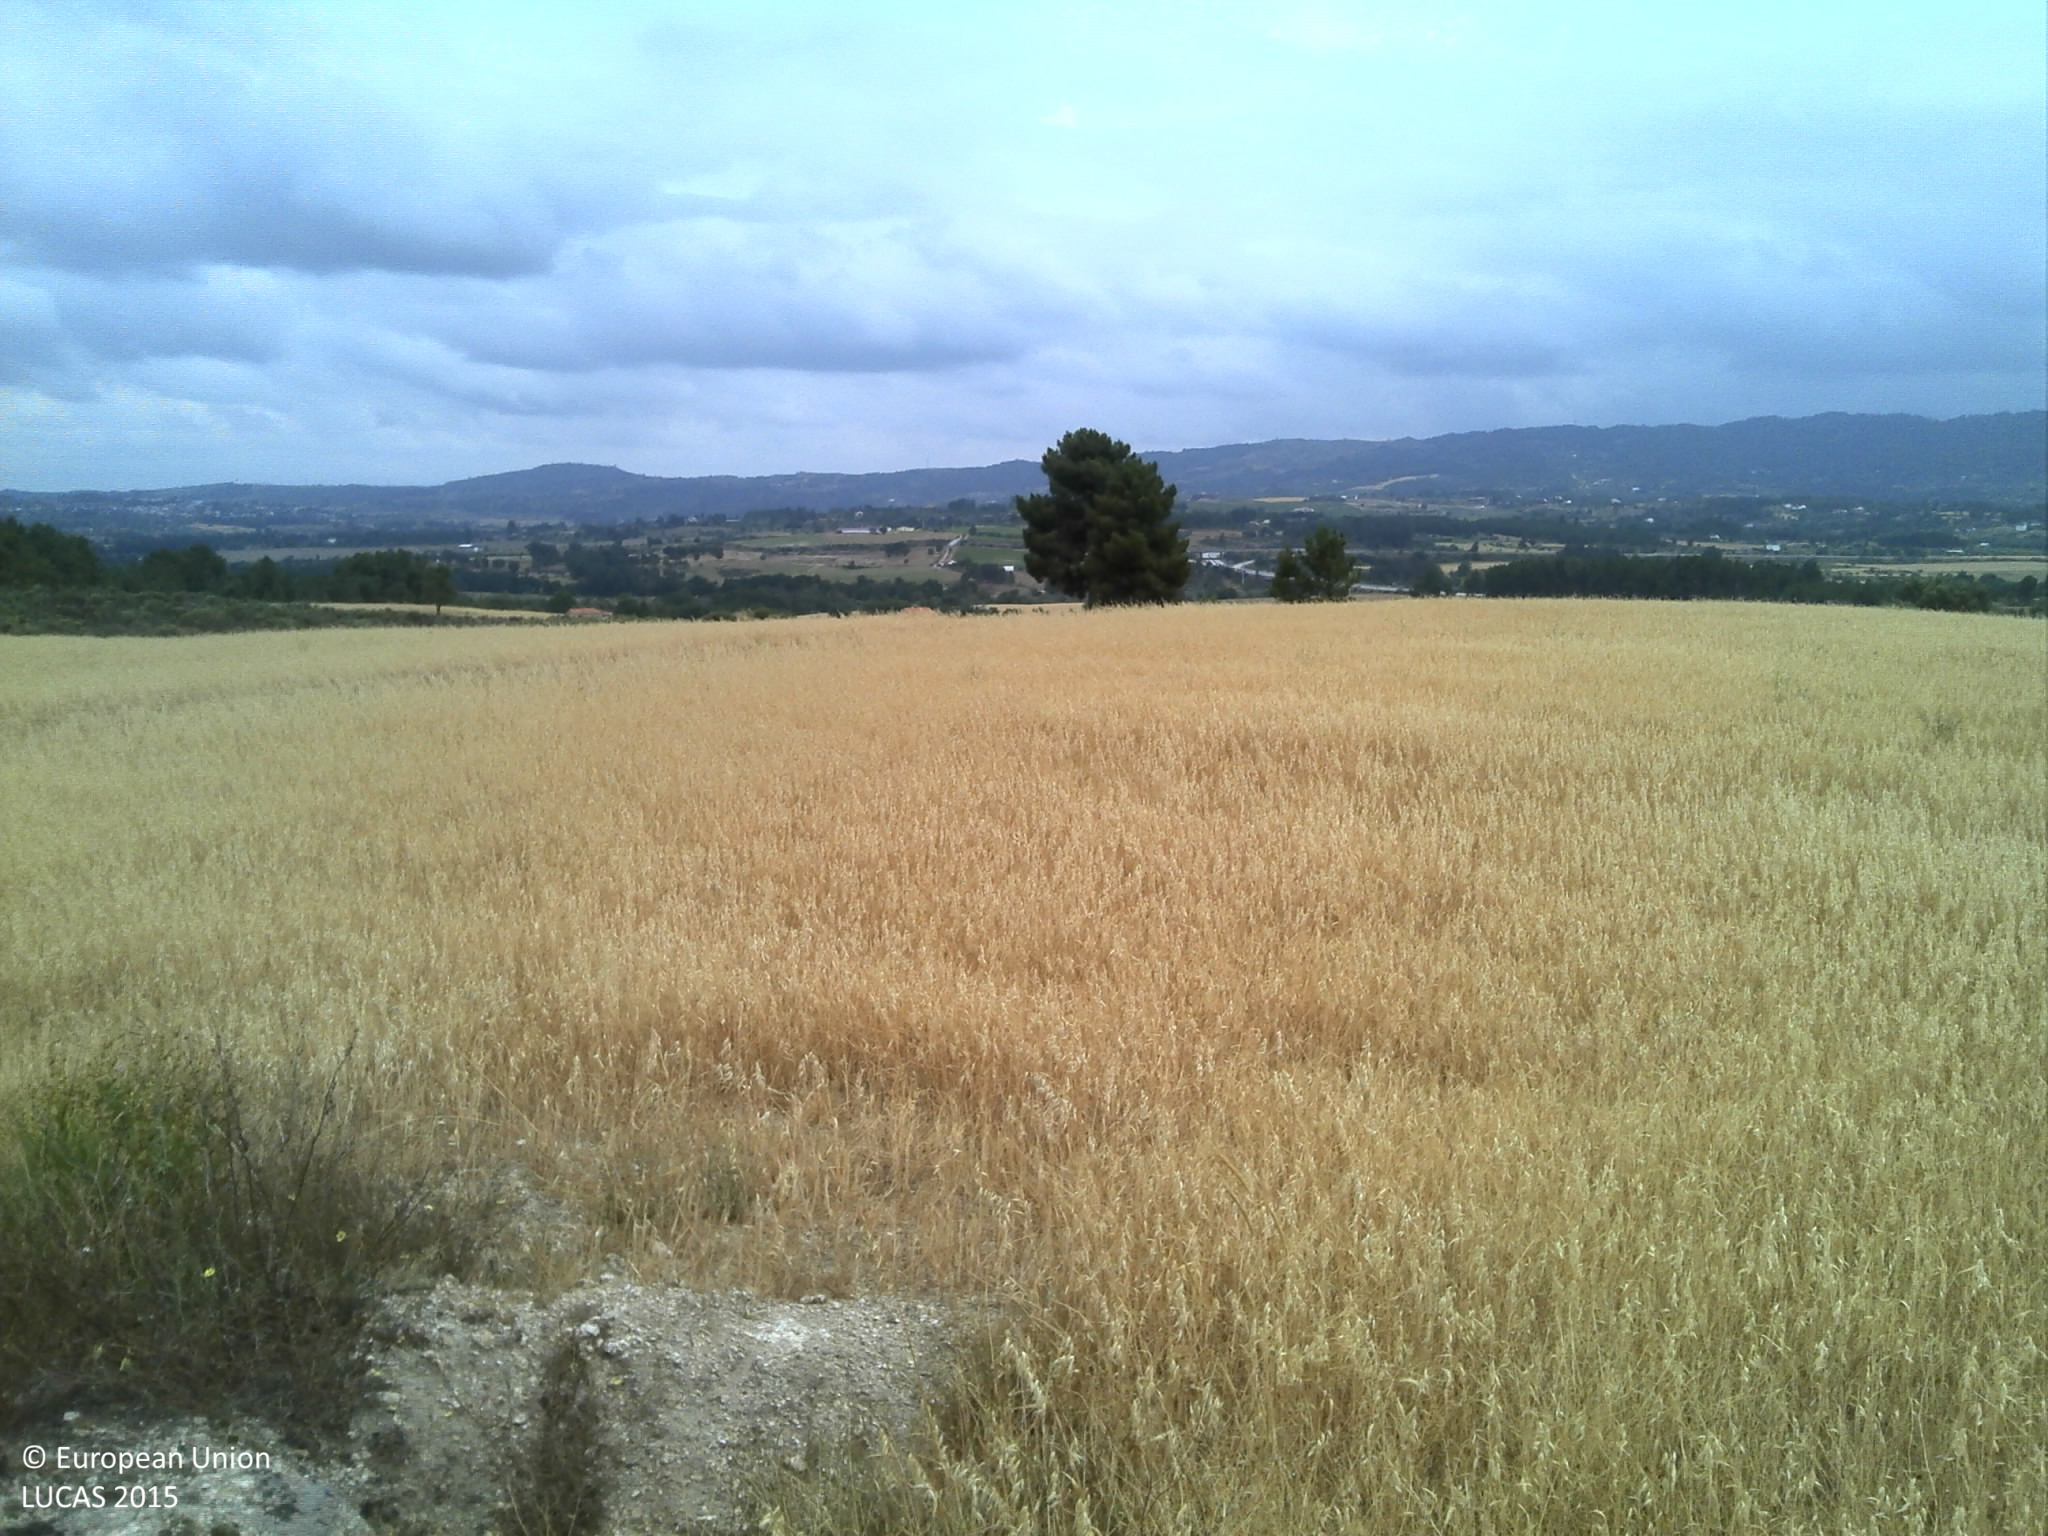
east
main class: Cropland
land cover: Oats
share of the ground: 50 - 75 %
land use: Agriculture (excluding fallow land and kitchen gardens)
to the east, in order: Oats; Tracks; Oats; Abandoned hedges; Tracks; Fences; Grassland without tree/shrub cover; Broadleaved woodland; Grassland without tree/shrub cover
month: June
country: PT
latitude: 40.2764
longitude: -7.4532
